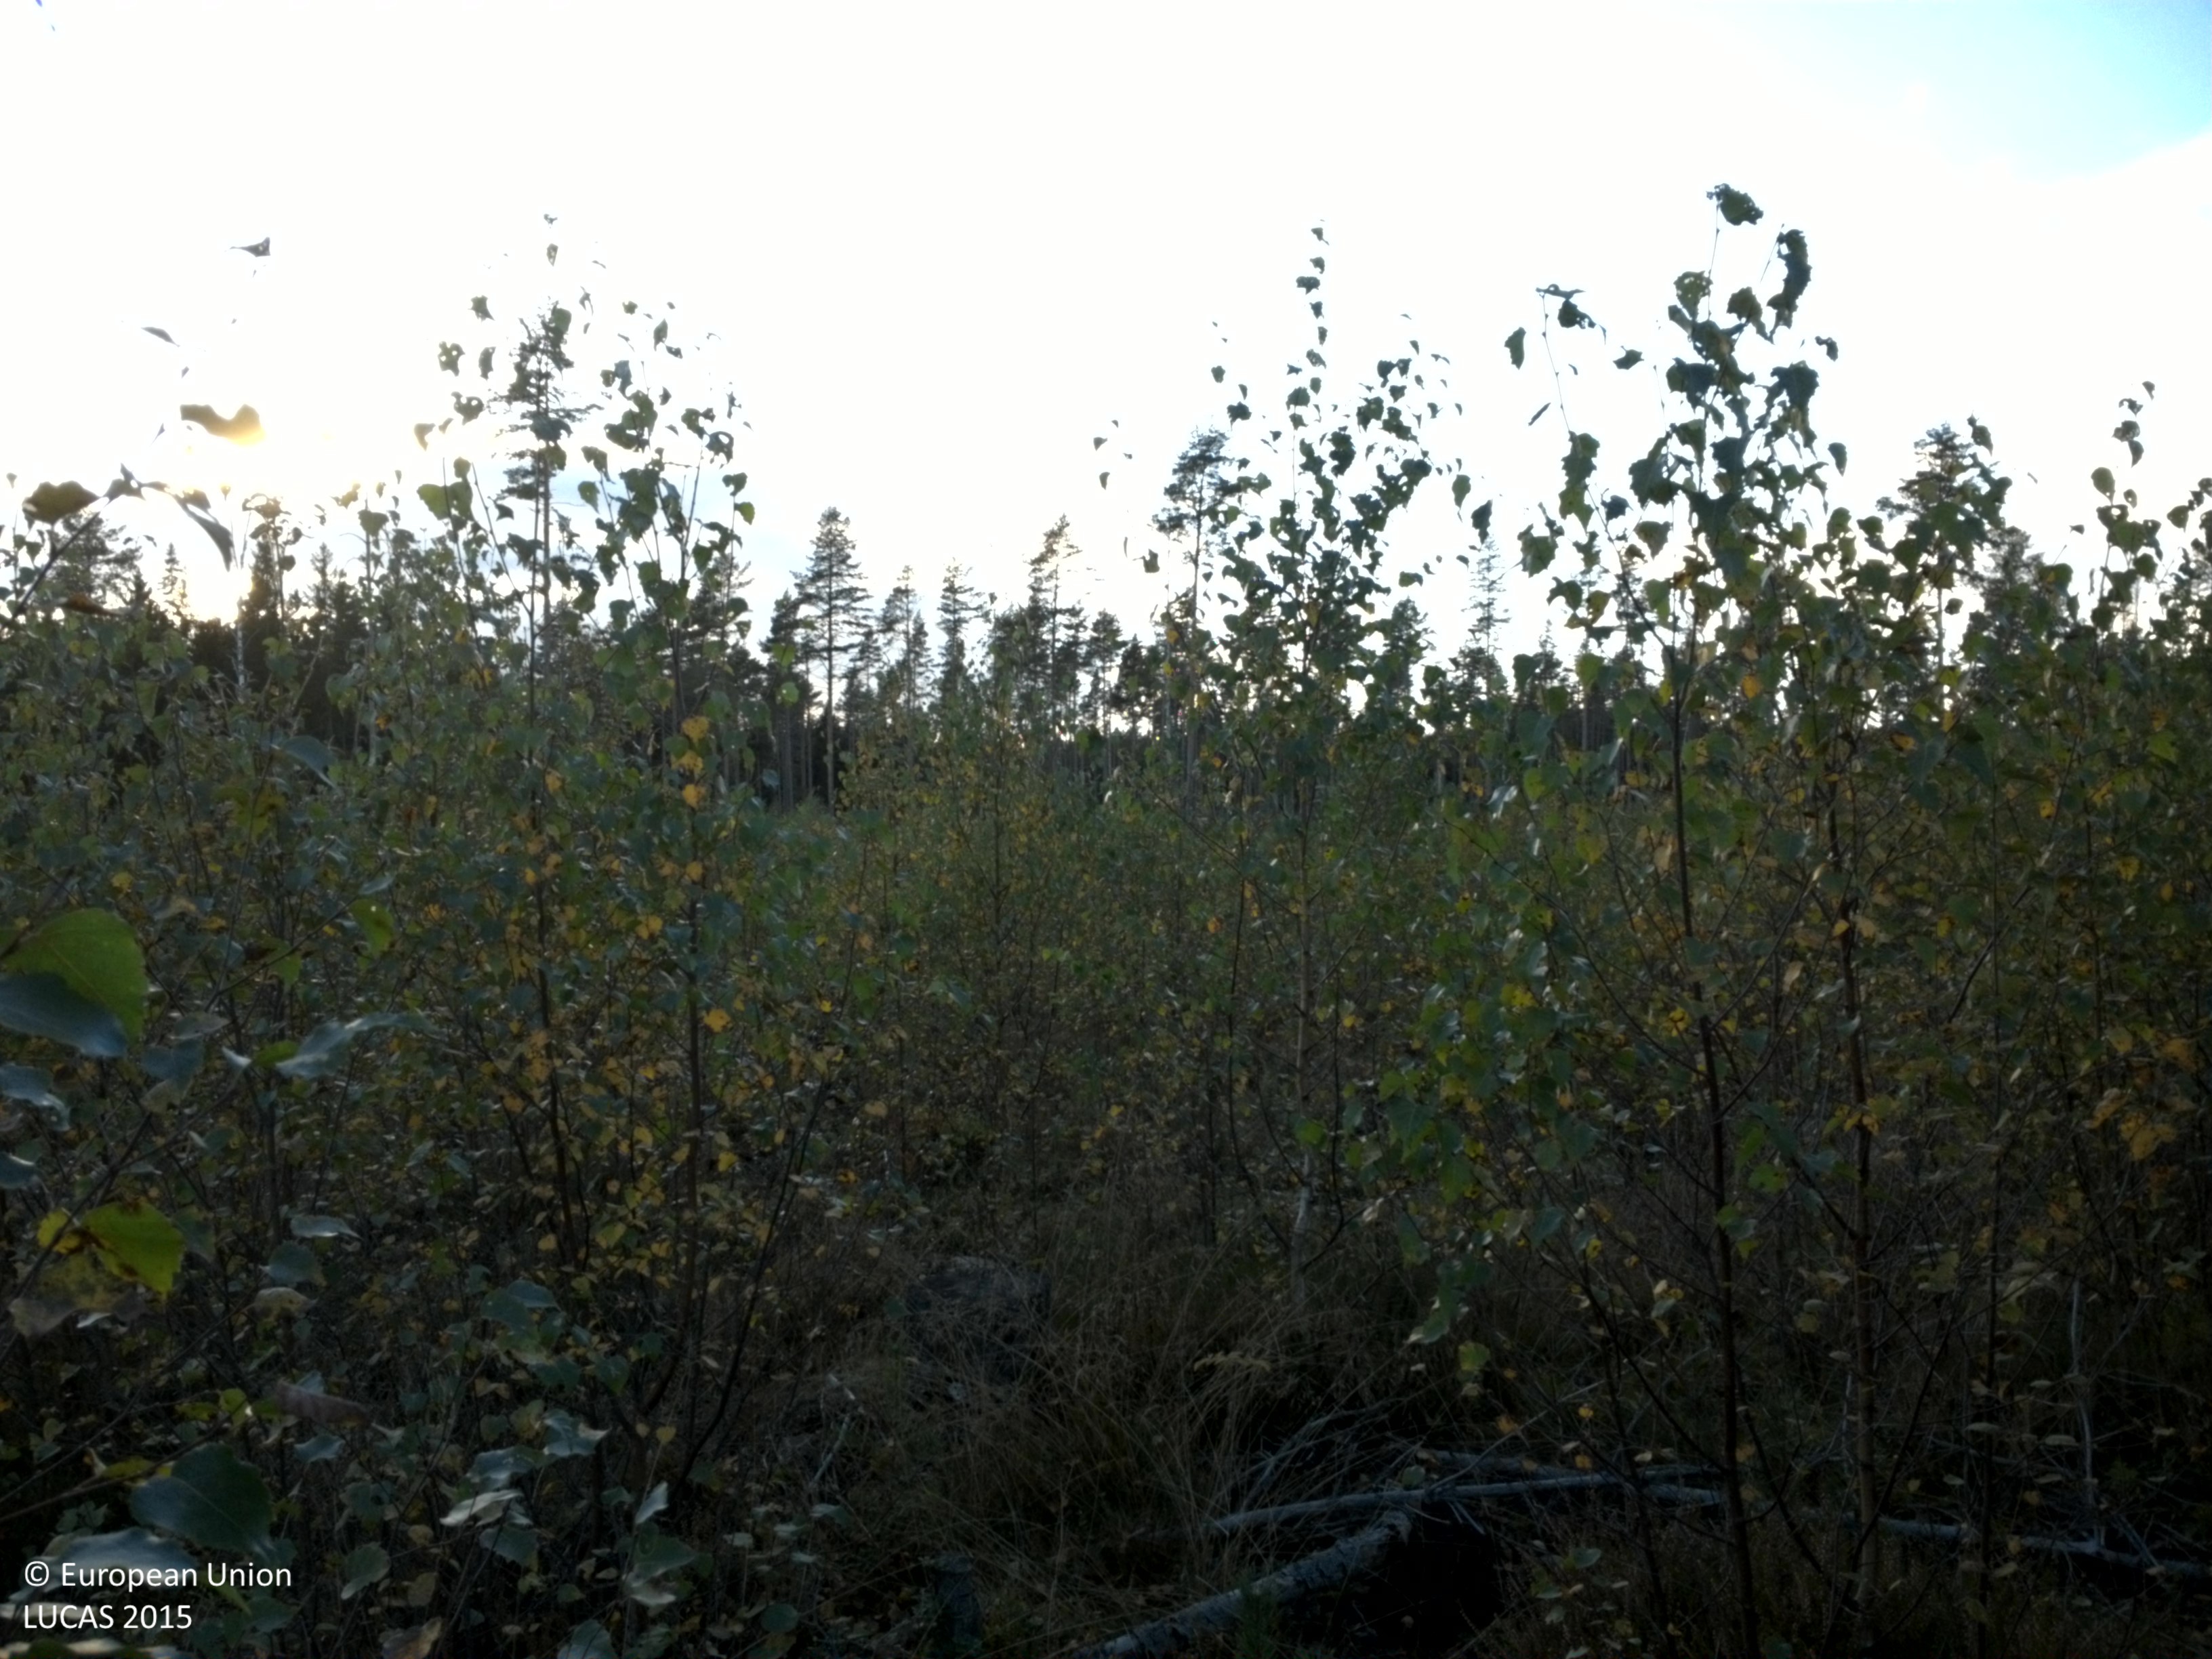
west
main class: Woodland
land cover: Broadleaved woodland
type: boreal forest
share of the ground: 25 - 50 %
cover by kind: broadleaved forest trees 45 %, herbaceous plants 40 %, unconsolidated bare surface 10 %, coniferous forest trees 5 %
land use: Forestry
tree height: < 5 m
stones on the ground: < 10 %
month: September
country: SE
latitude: 59.9736
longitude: 16.5659
